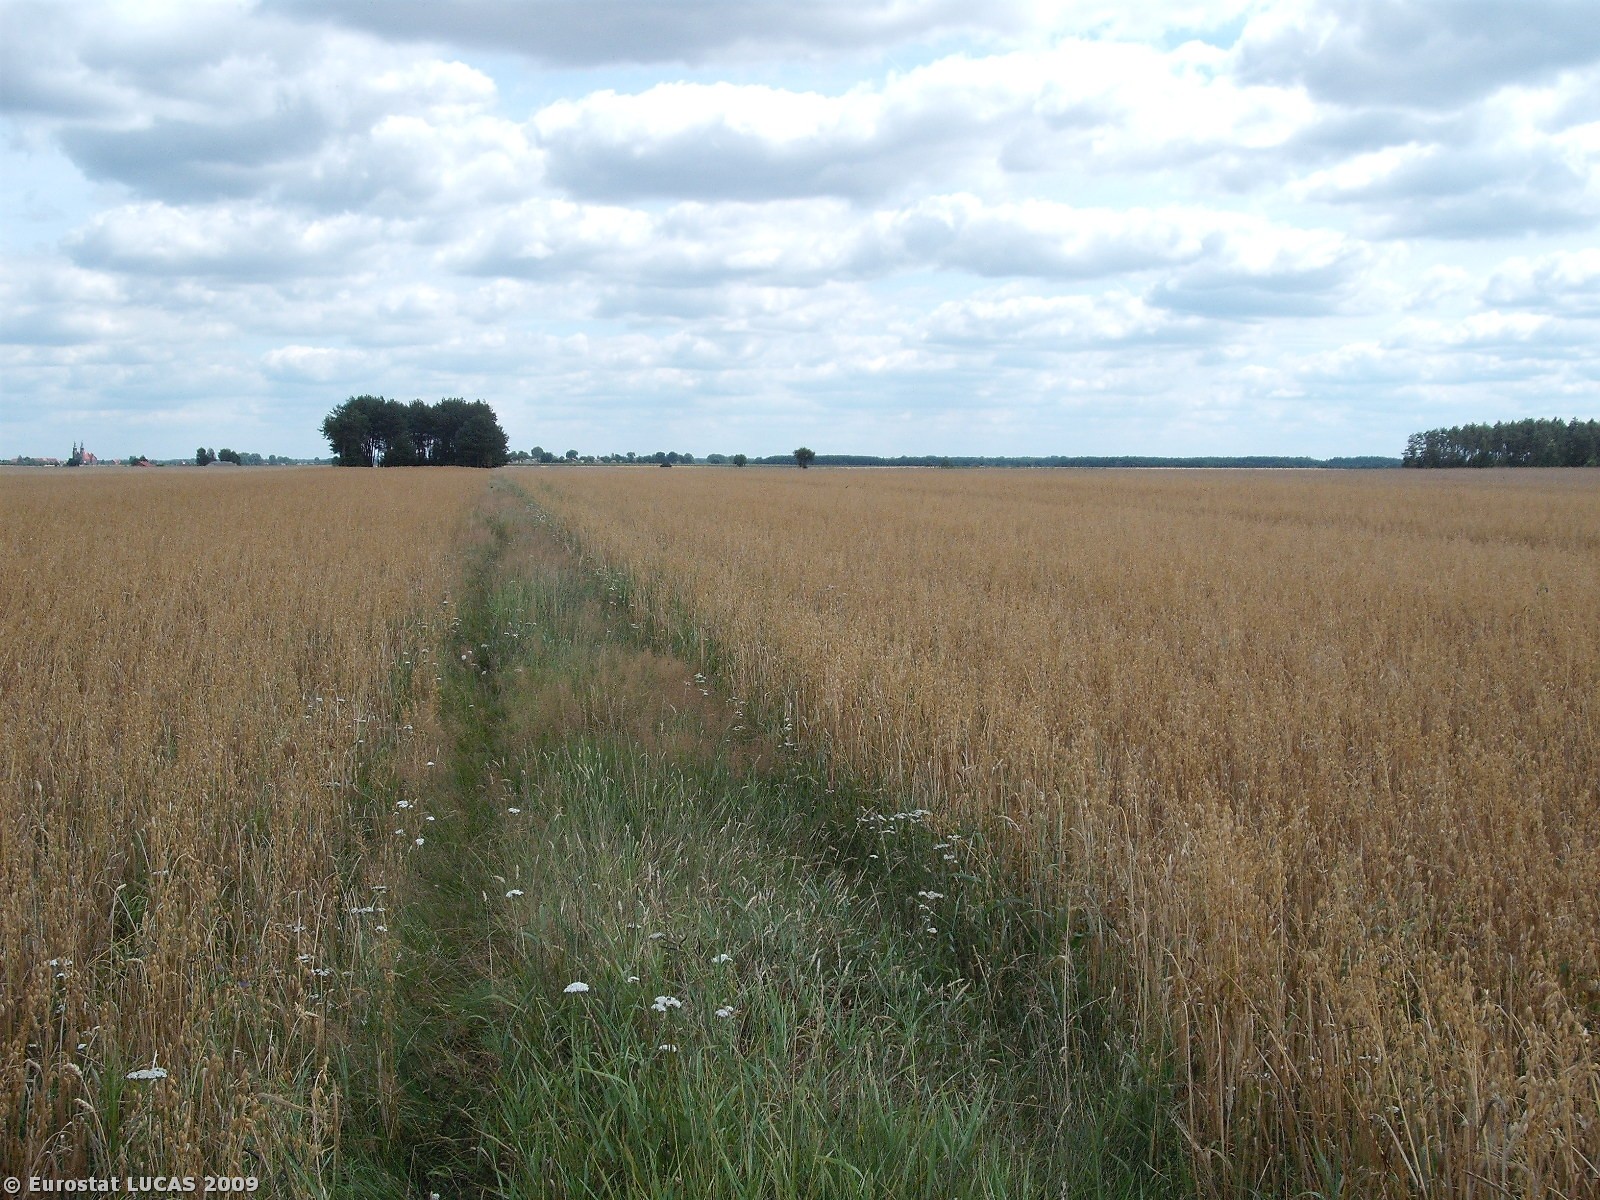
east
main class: Cropland
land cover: Barley
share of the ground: 50 - 75 %
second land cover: Oats
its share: 25 - 50 %
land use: Agriculture (excluding fallow land and kitchen gardens)
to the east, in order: Barley; Oats
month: July
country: PL
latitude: 51.3178
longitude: 21.3992
